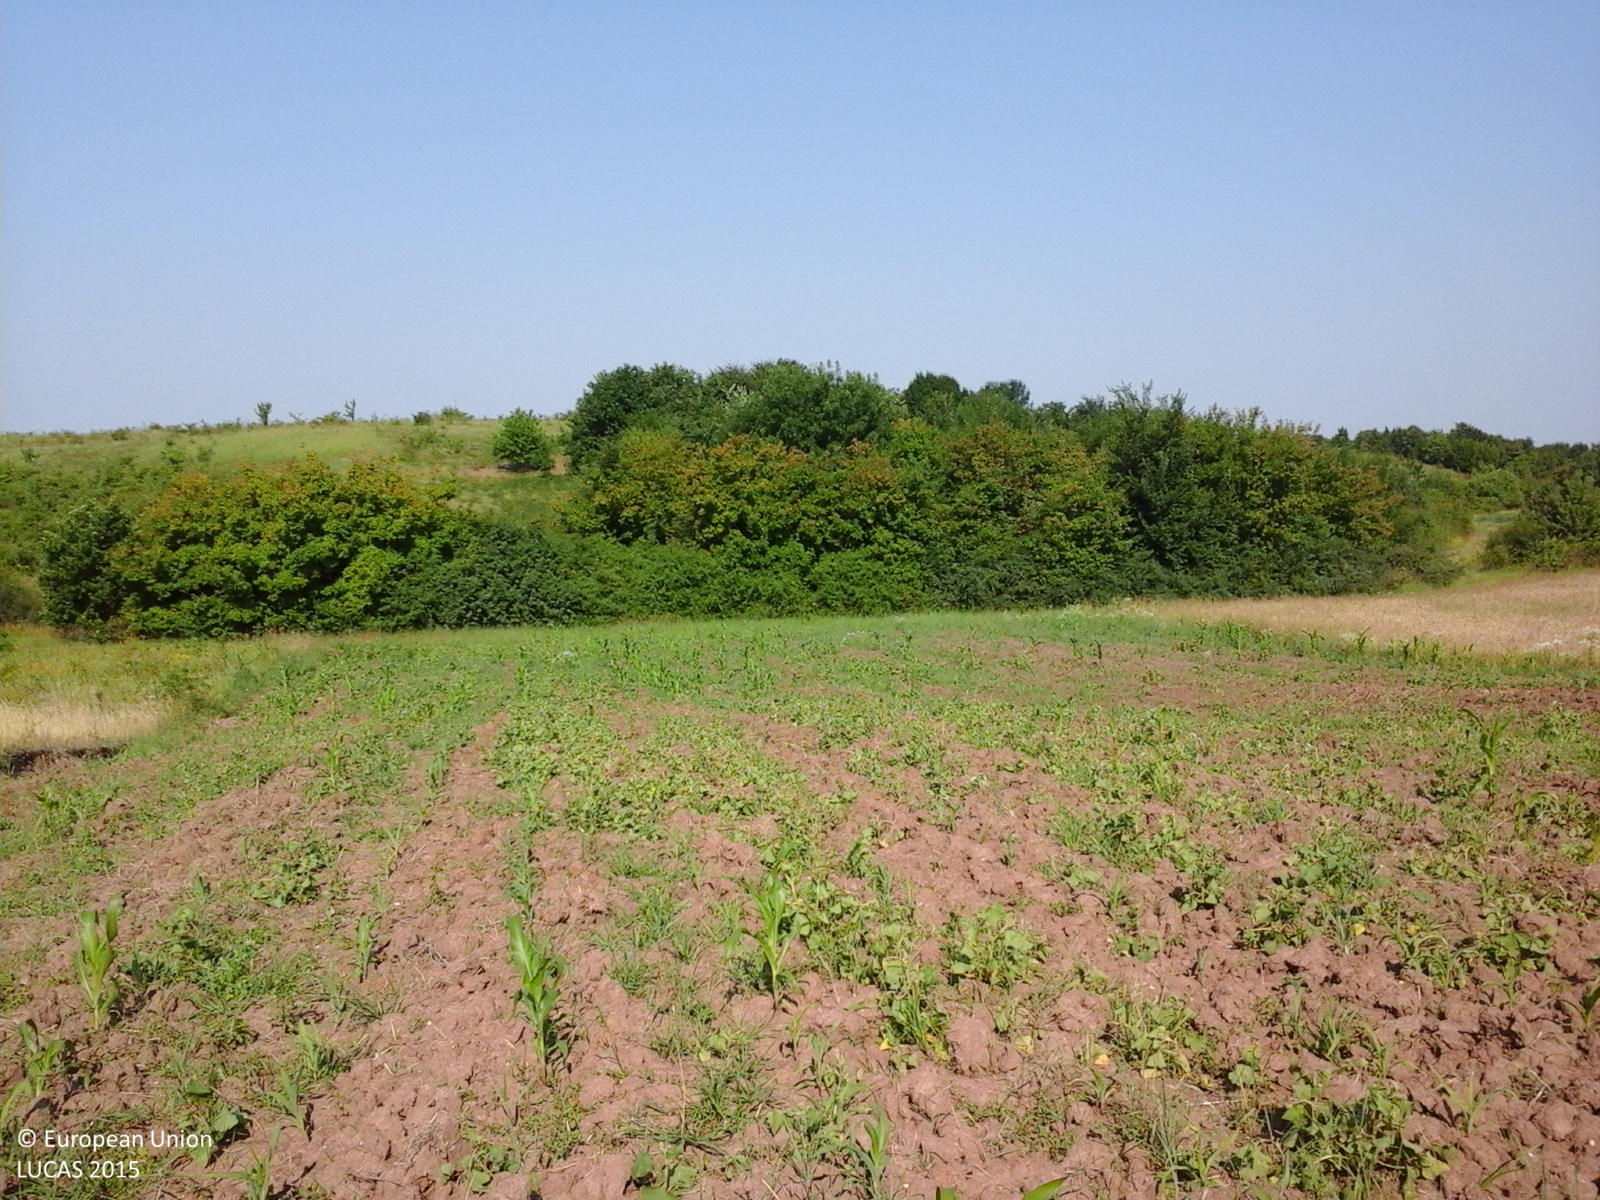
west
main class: Cropland
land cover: Maize
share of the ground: < 10 %
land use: Agriculture (excluding fallow land and kitchen gardens)
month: July
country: RO
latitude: 44.6105
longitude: 24.6028
